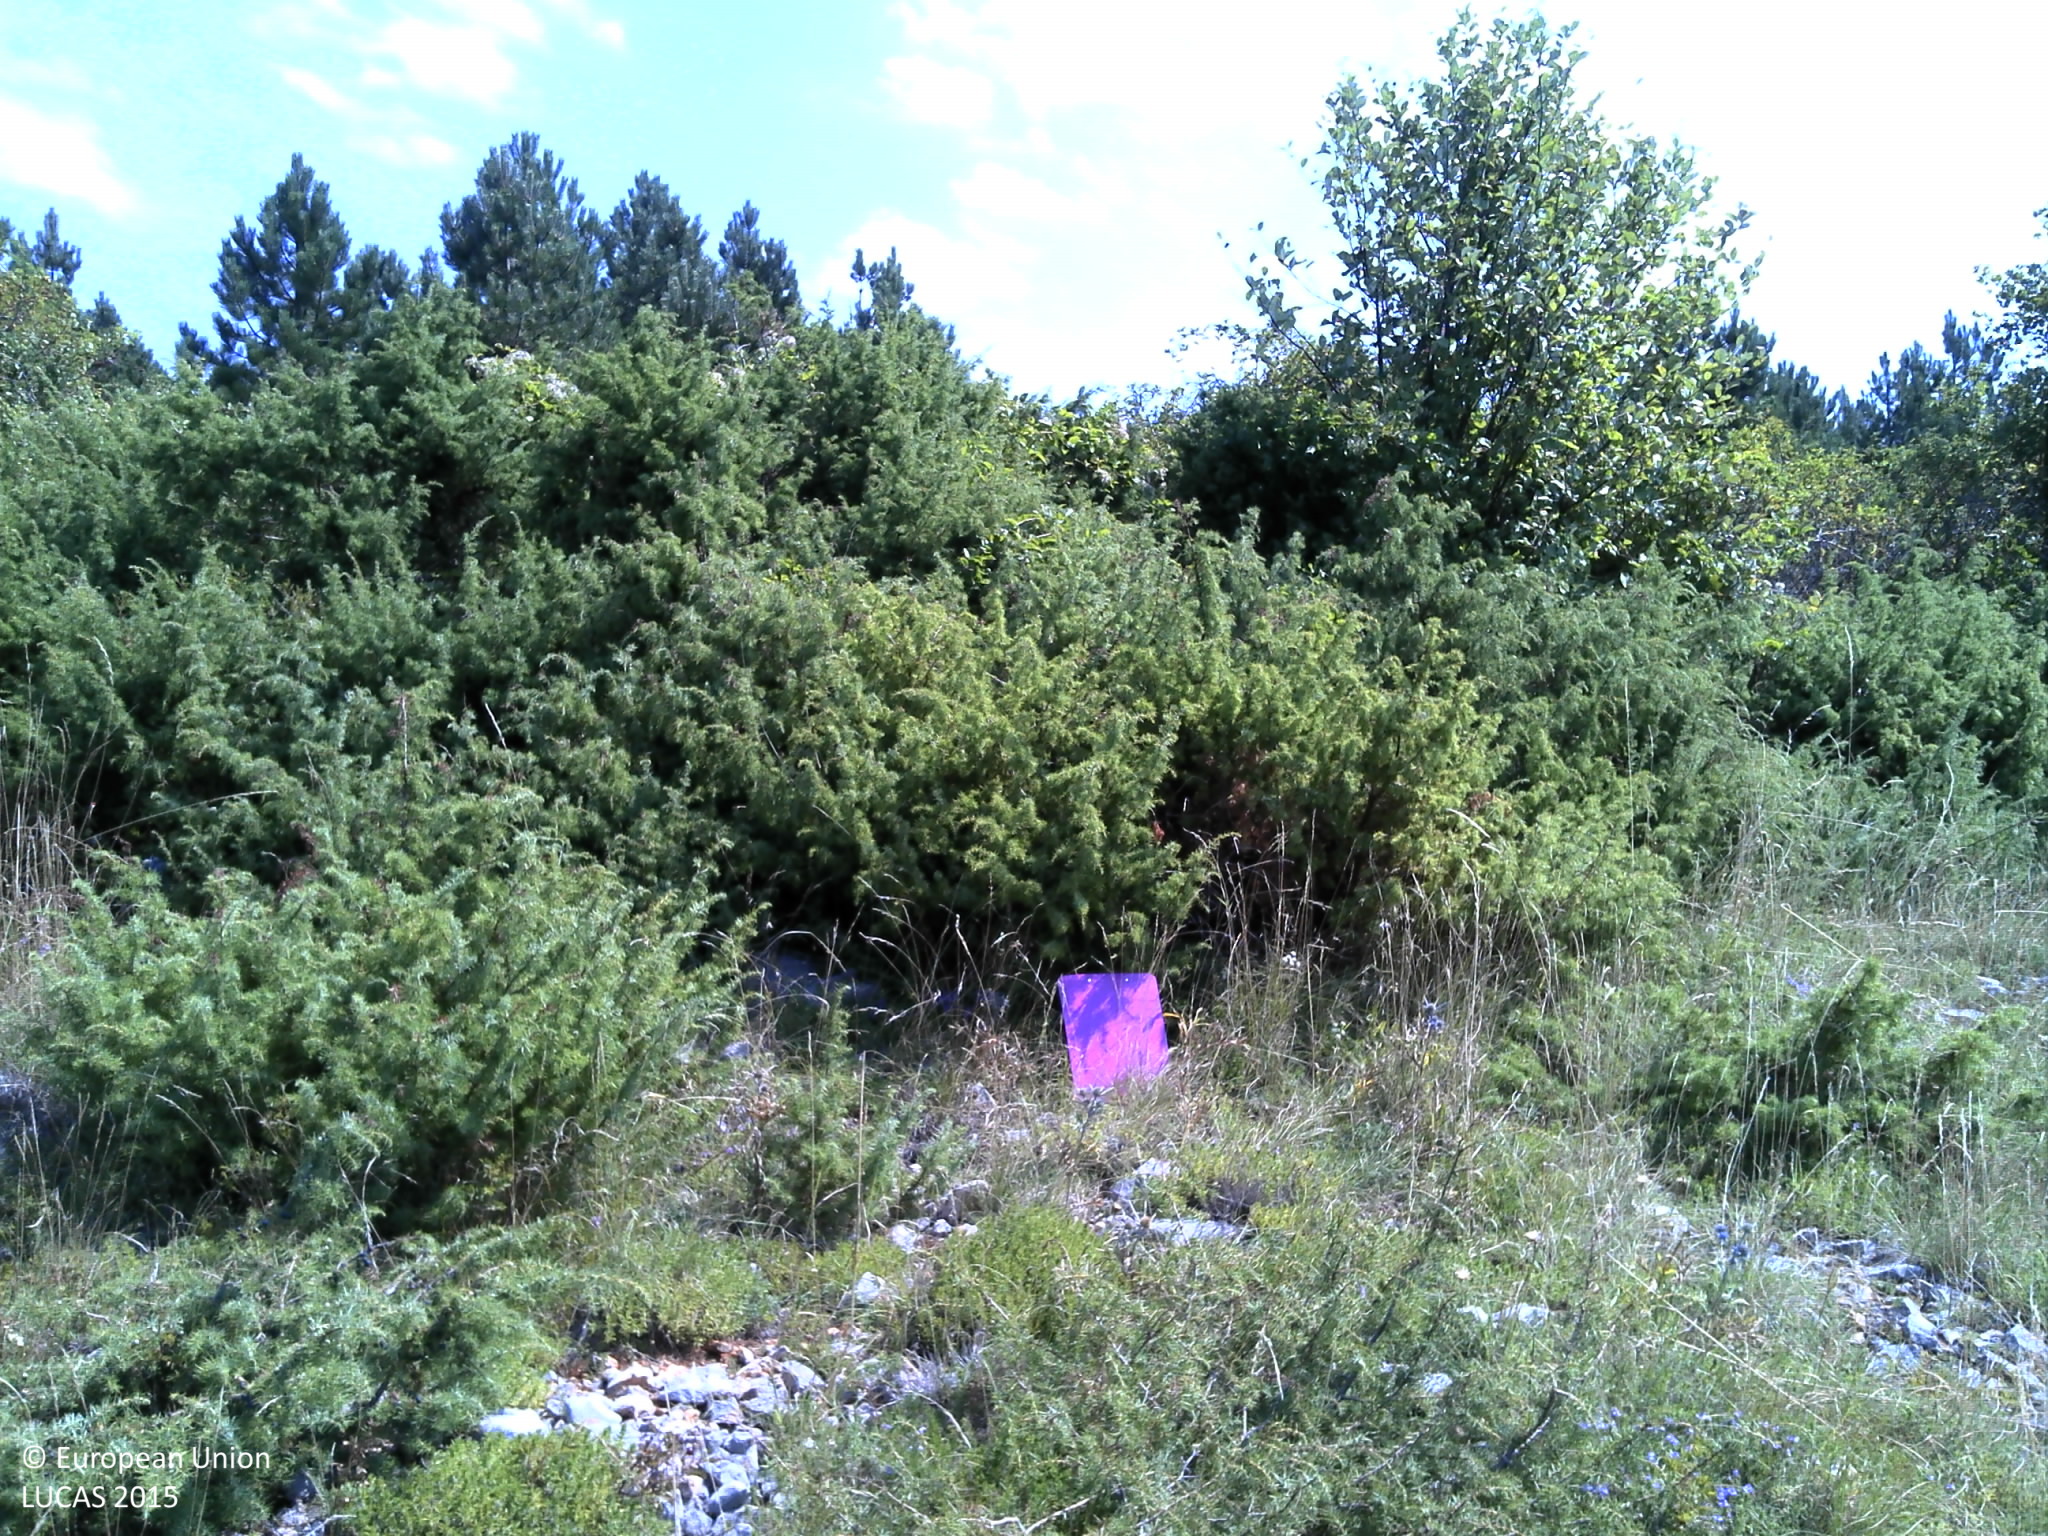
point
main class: Shrubland
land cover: Shrubland with sparse tree cover
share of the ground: > 75 %
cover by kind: shrubs 65 %, herbaceous plants 20 %, coniferous forest trees 5 %, consolidated bare surface 5 %, unconsolidated bare surface 5 %
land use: Semi-natural and natural areas not in use
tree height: < 5 m
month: August
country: HR
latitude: 45.0089
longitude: 14.9553
